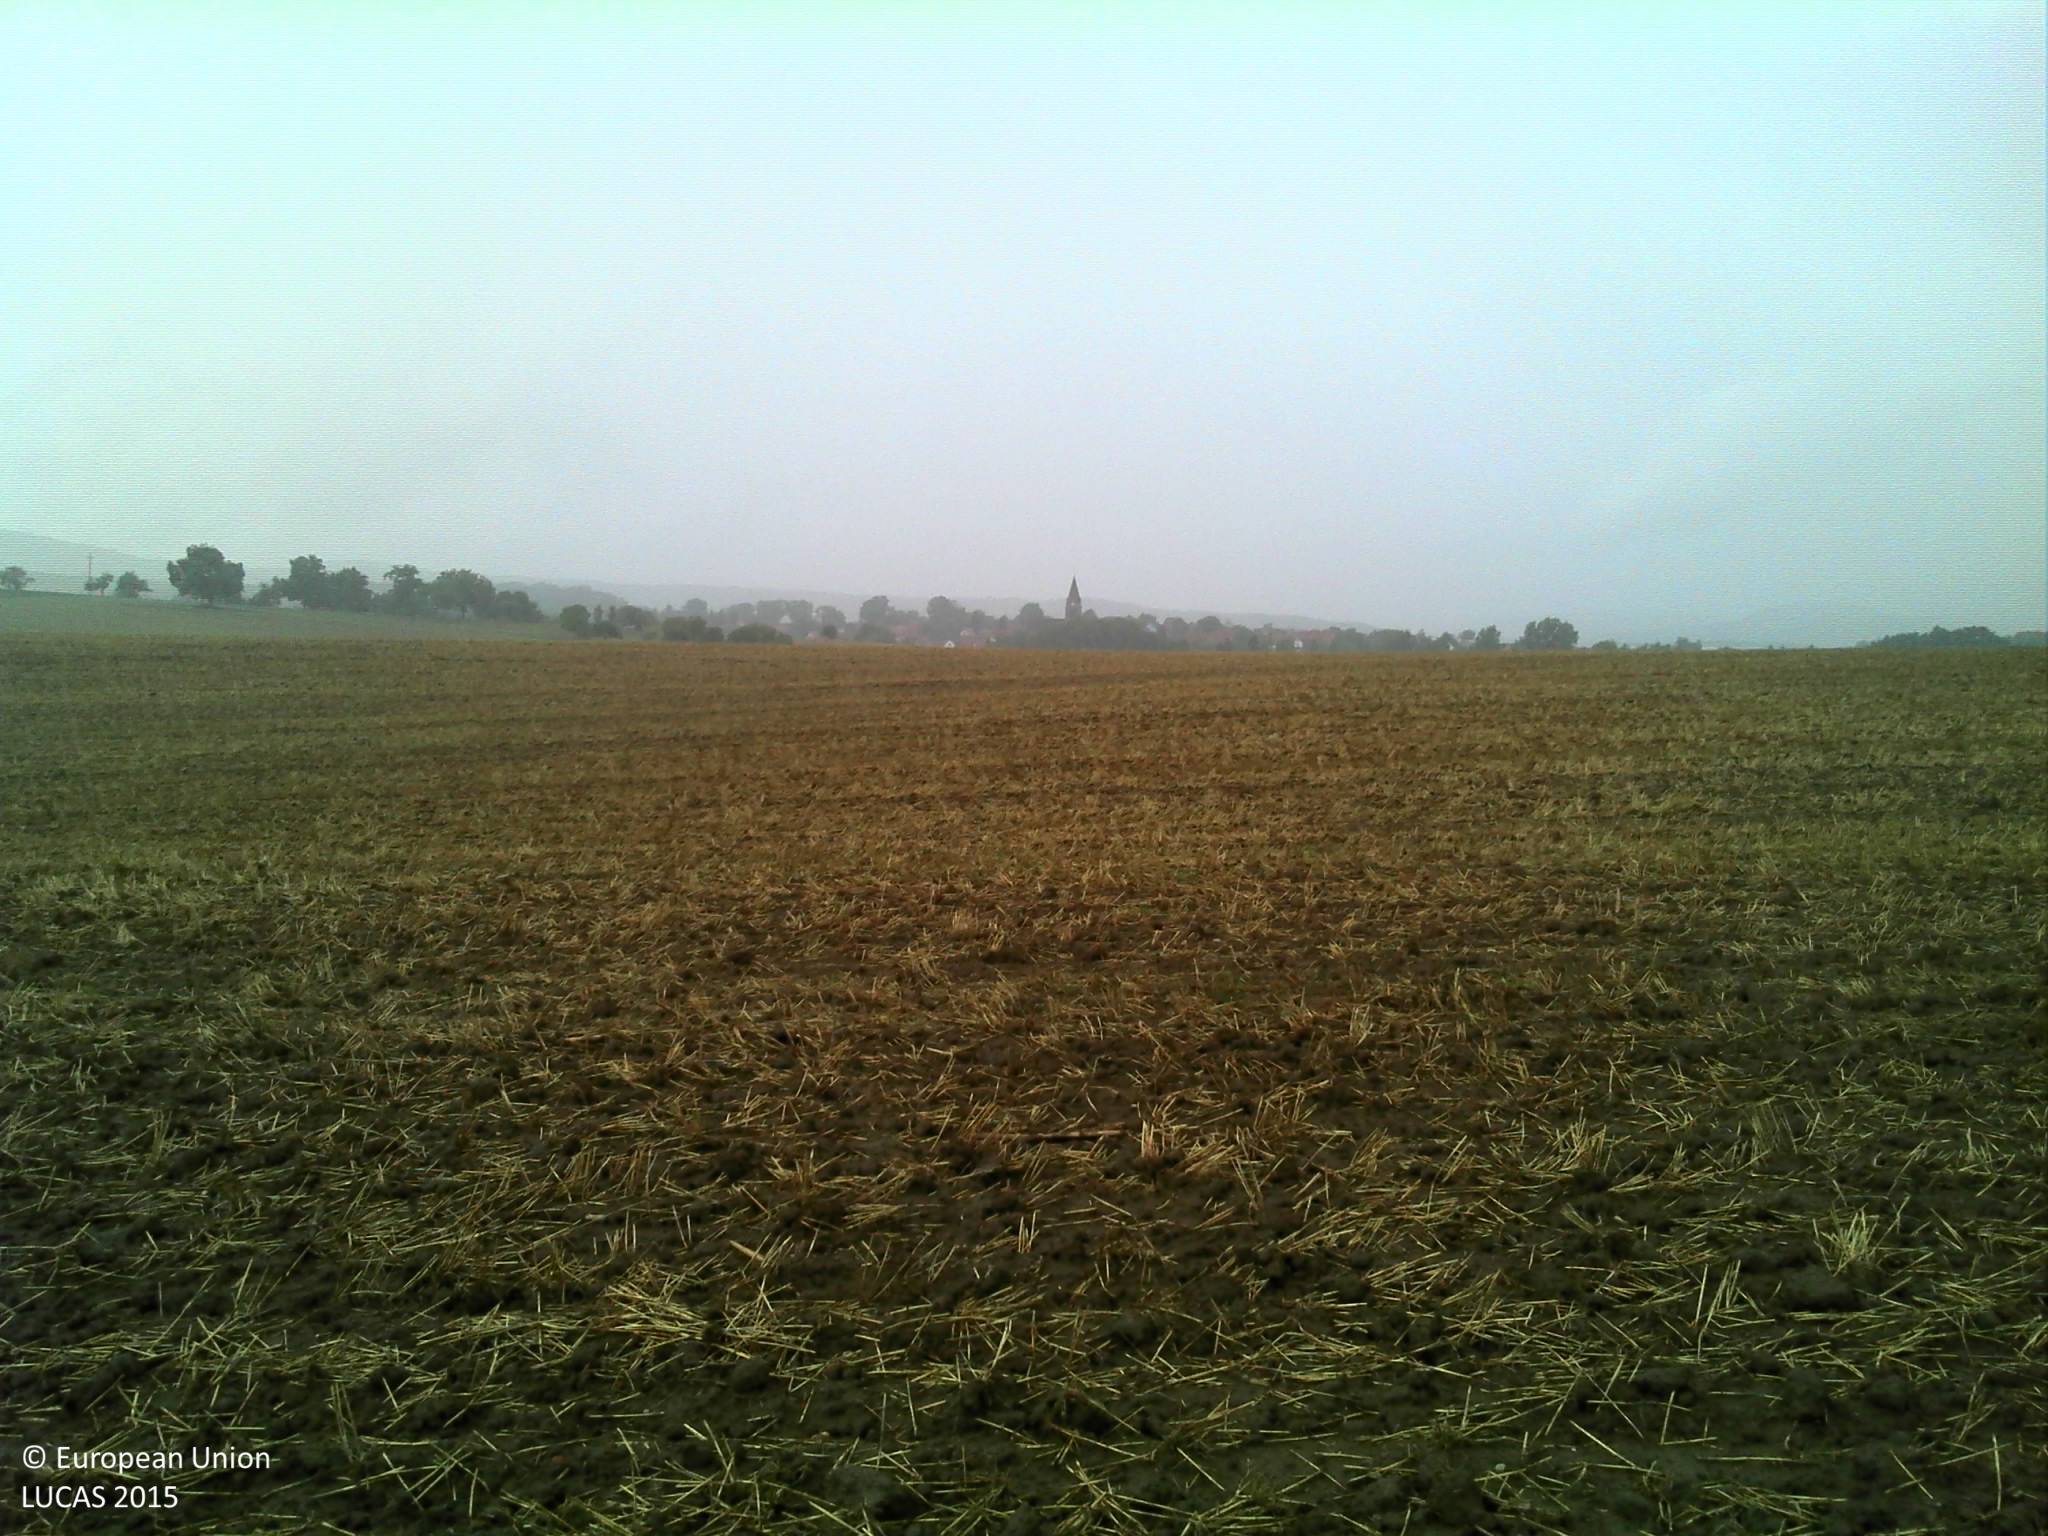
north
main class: Cropland
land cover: Triticale
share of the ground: 10 - 25 %
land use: Agriculture (excluding fallow land and kitchen gardens)
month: August
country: FR
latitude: 48.8422
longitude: 7.4526
